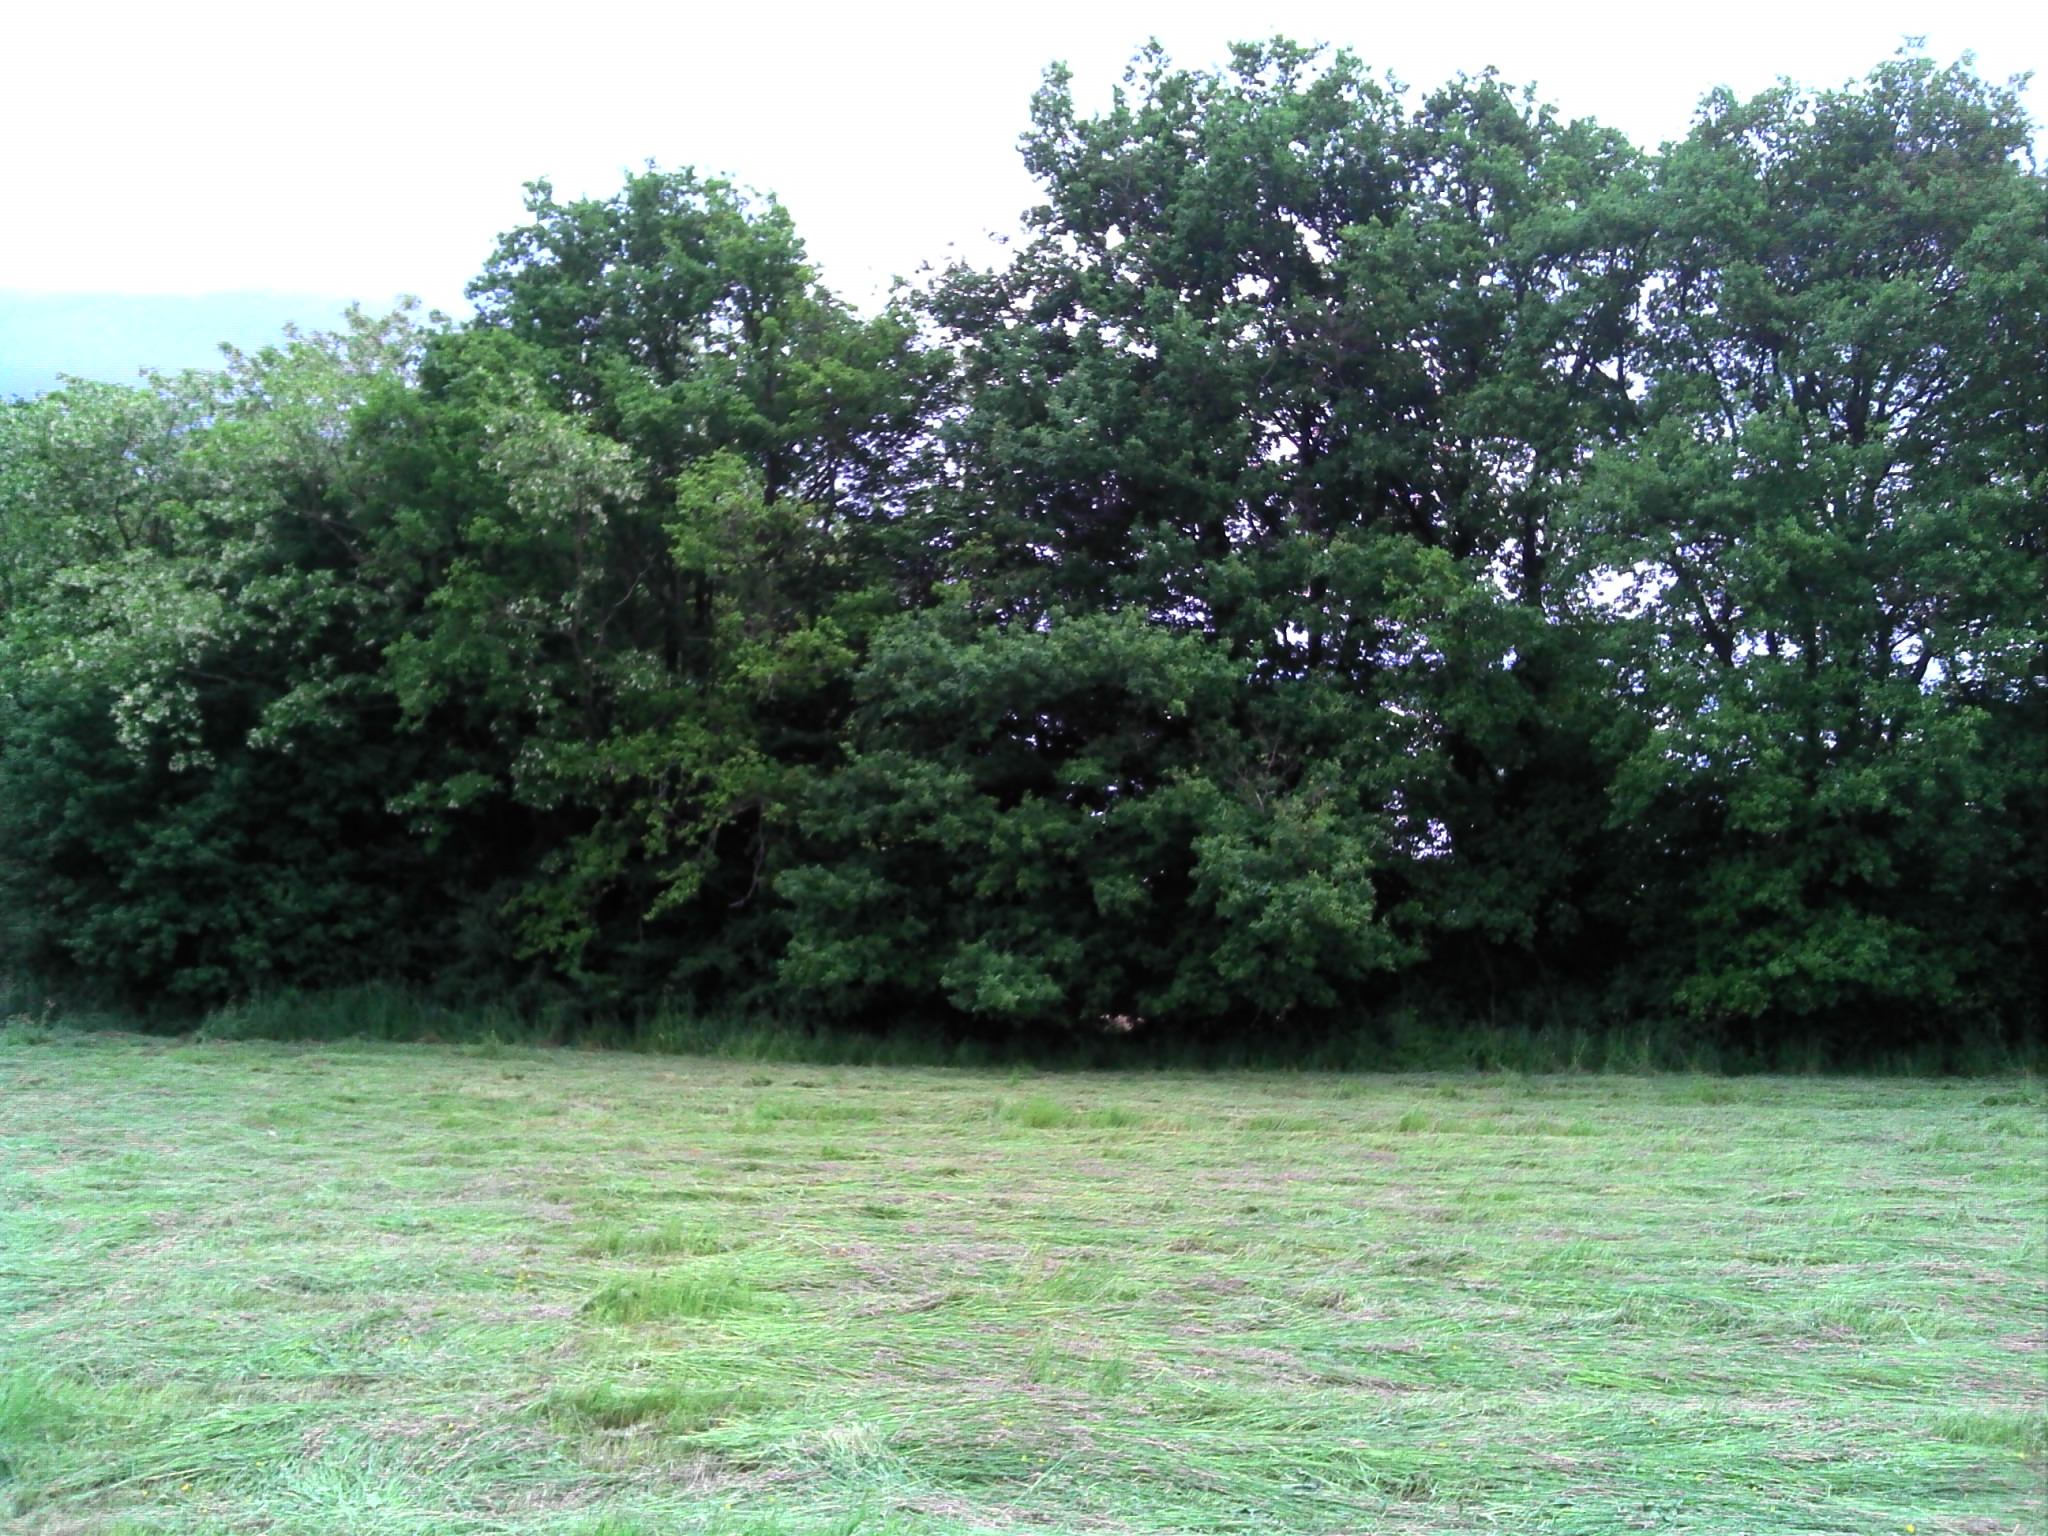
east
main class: Grassland
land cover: Grassland without tree/shrub cover
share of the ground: > 75 %
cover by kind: herbaceous plants 100 %
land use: Agriculture (excluding fallow land and kitchen gardens)
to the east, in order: Grassland without tree/shrub cover; Broadleaved woodland; Grass margins; Tracks; Grass margins; Rye; Grass margins; Tracks; Broadleaved woodland; Rye; Managed hedges; Fences; Common wheat
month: May
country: FR
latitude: 47.4132
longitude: 2.8503
